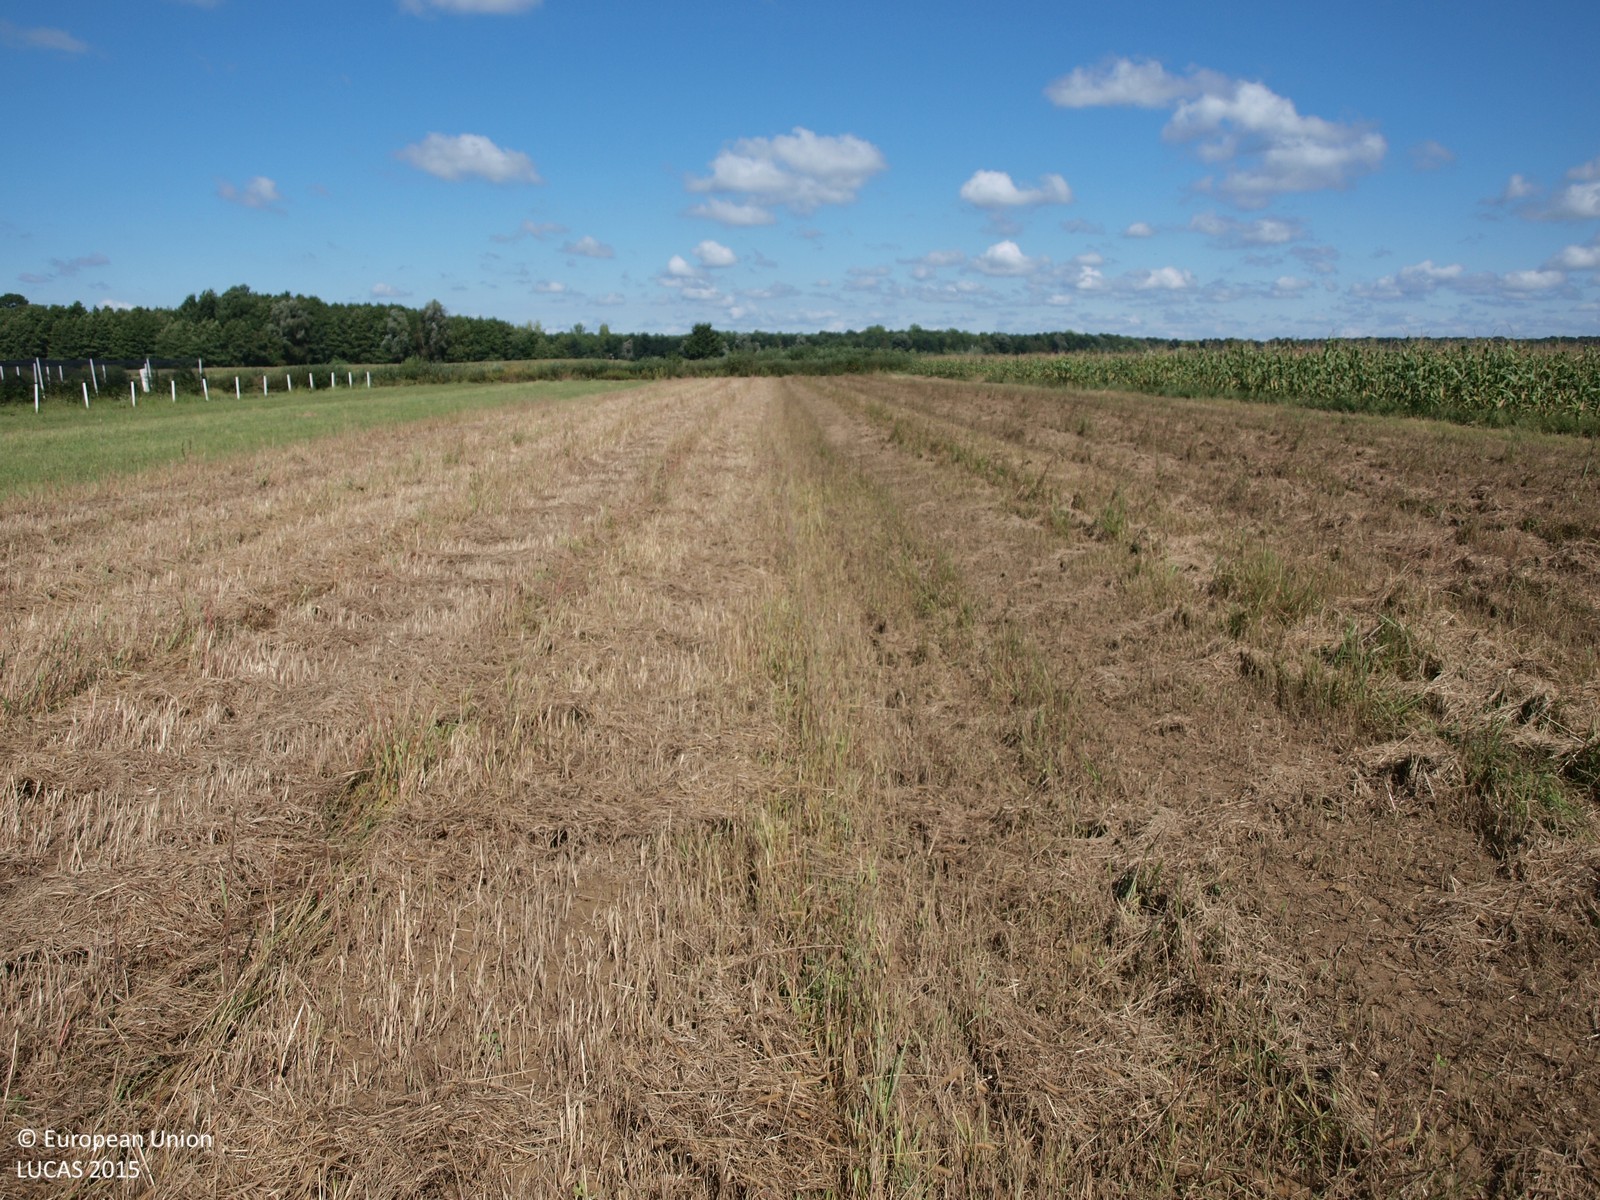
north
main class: Grassland
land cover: Grassland without tree/shrub cover
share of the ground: > 75 %
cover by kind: herbaceous plants 100 %
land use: Agriculture (excluding fallow land and kitchen gardens)
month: September
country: HR
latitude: 45.7791
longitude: 16.4166
